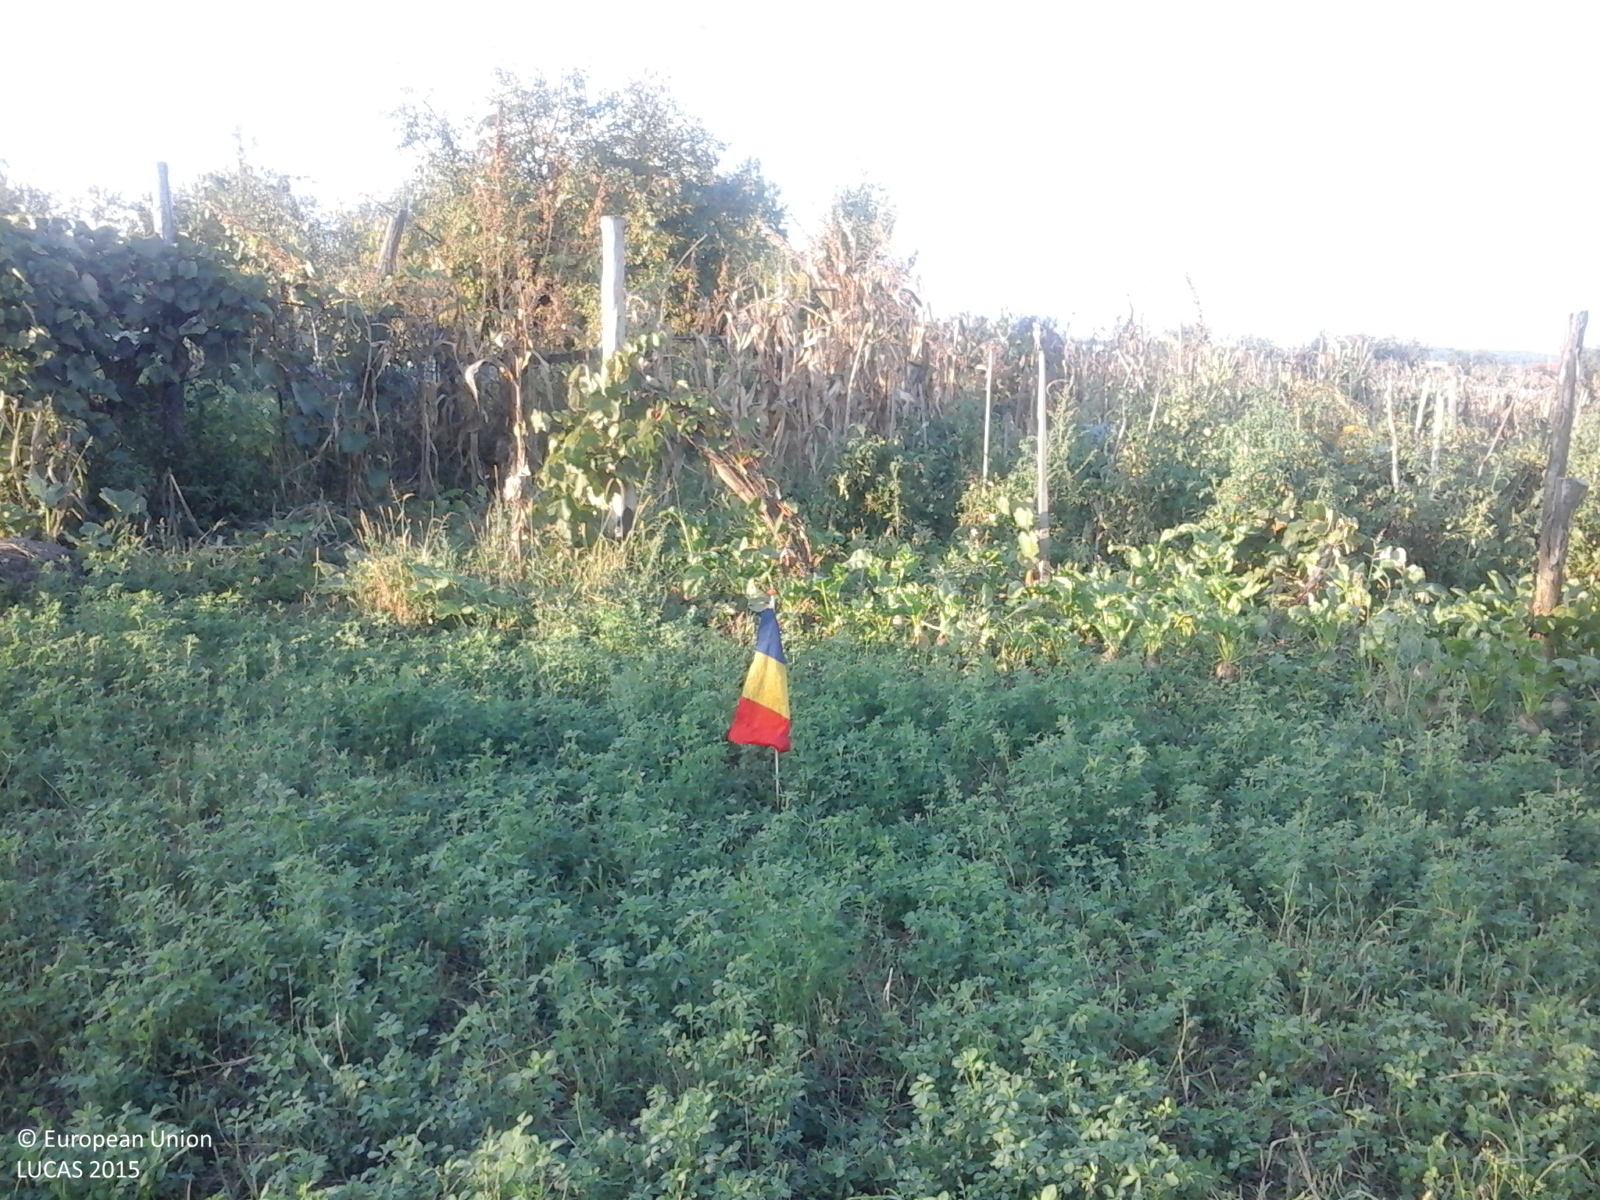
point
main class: Cropland
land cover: Lucerne
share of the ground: > 75 %
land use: Agriculture (excluding fallow land and kitchen gardens)
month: September
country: RO
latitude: 45.0213
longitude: 23.6000
